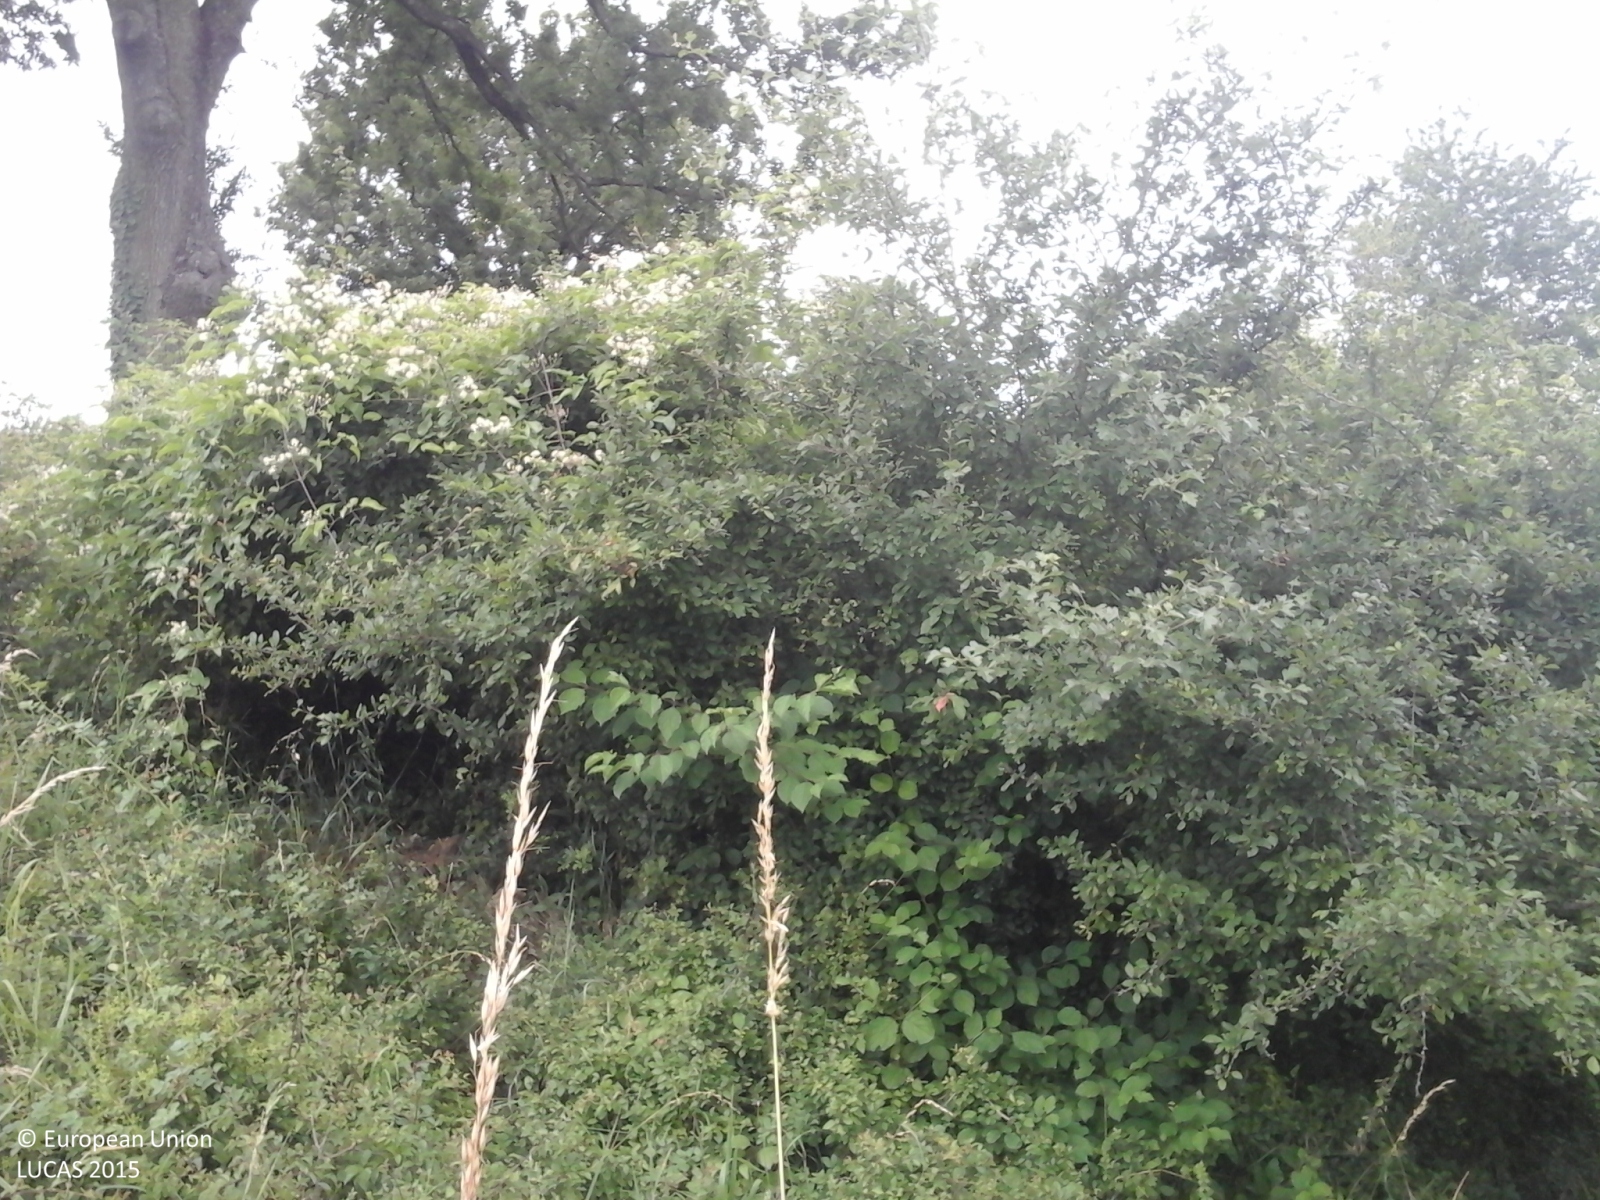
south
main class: Woodland
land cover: Broadleaved woodland
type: thermophilous deciduous forest
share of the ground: > 75 %
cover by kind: broadleaved forest trees 90 %, shrubs 10 %
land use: Forestry
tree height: > 5 m
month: June
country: IT
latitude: 44.6026
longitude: 10.2891
